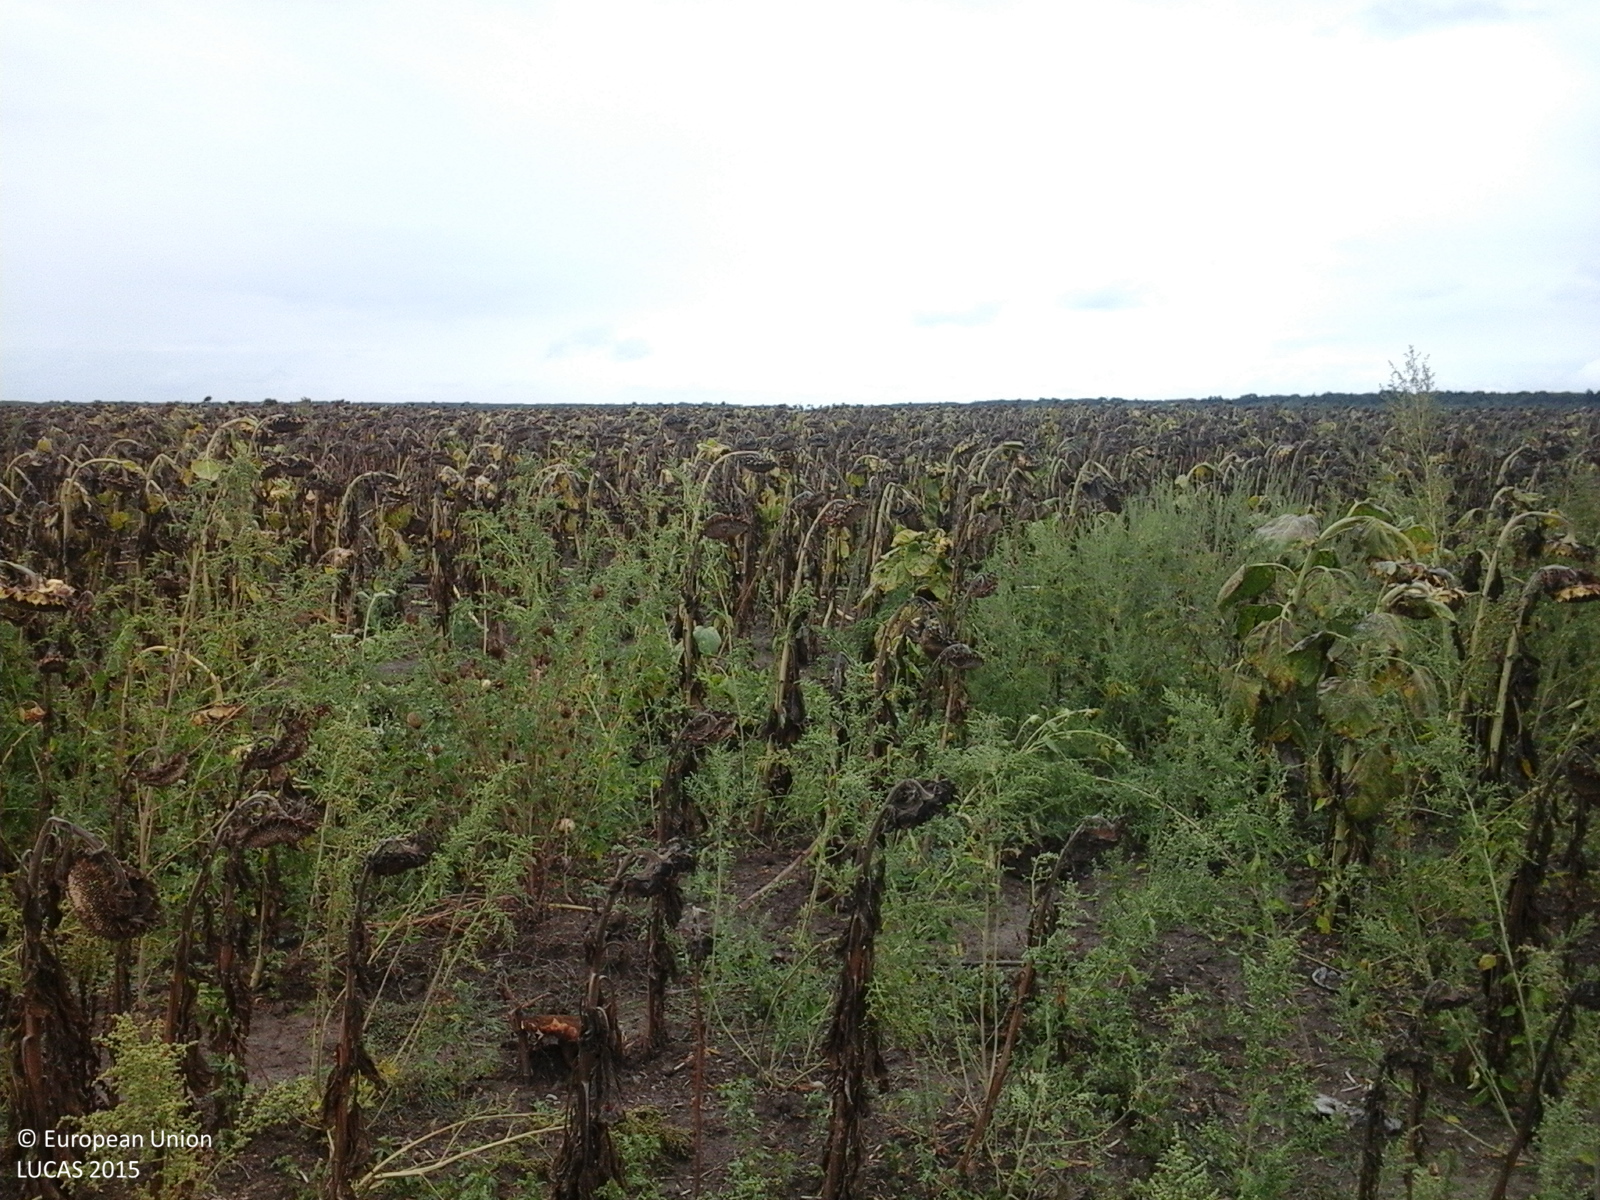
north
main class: Cropland
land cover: Sunflower
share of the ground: > 75 %
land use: Agriculture (excluding fallow land and kitchen gardens)
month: September
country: RO
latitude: 46.8353
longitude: 21.8572
